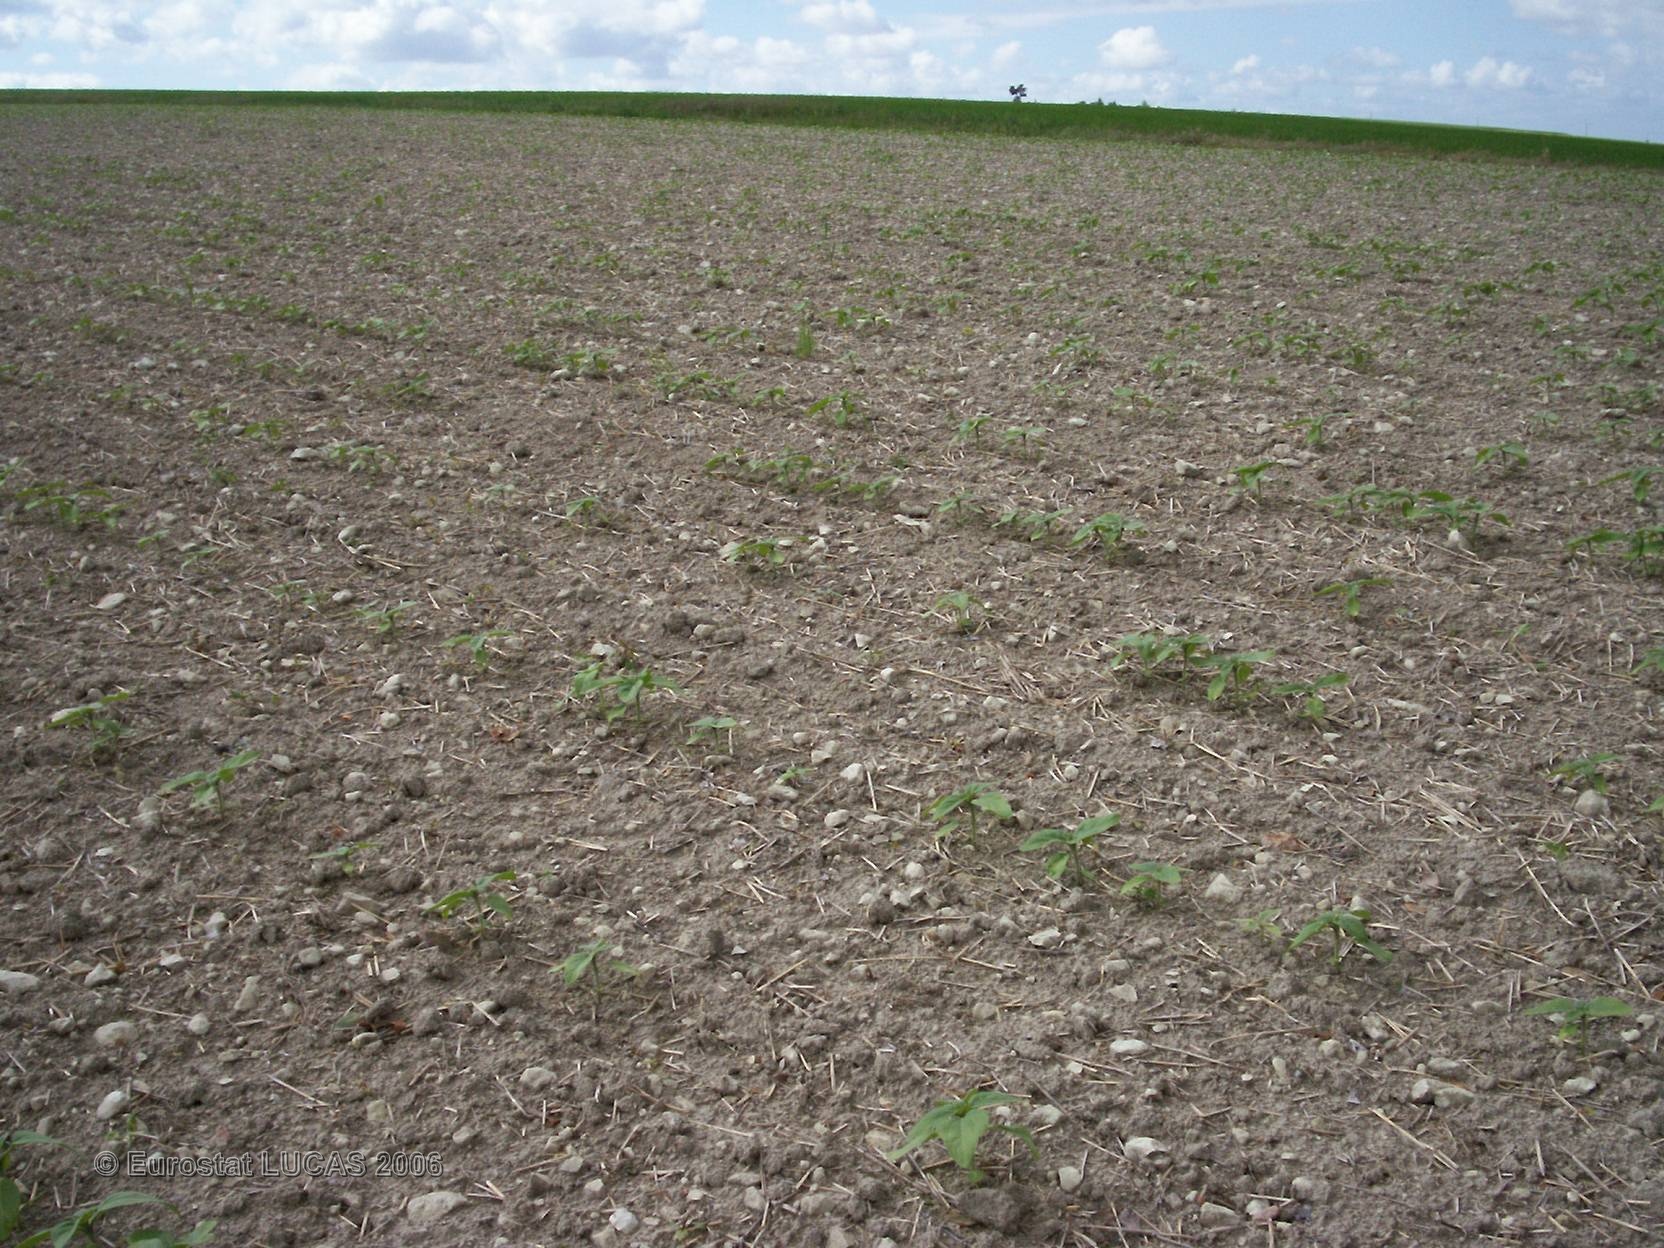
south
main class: Cropland
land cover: Sunflower
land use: Agriculture (excluding fallow land and kitchen gardens)
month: May
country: FR
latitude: 46.8558
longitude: 0.3395
